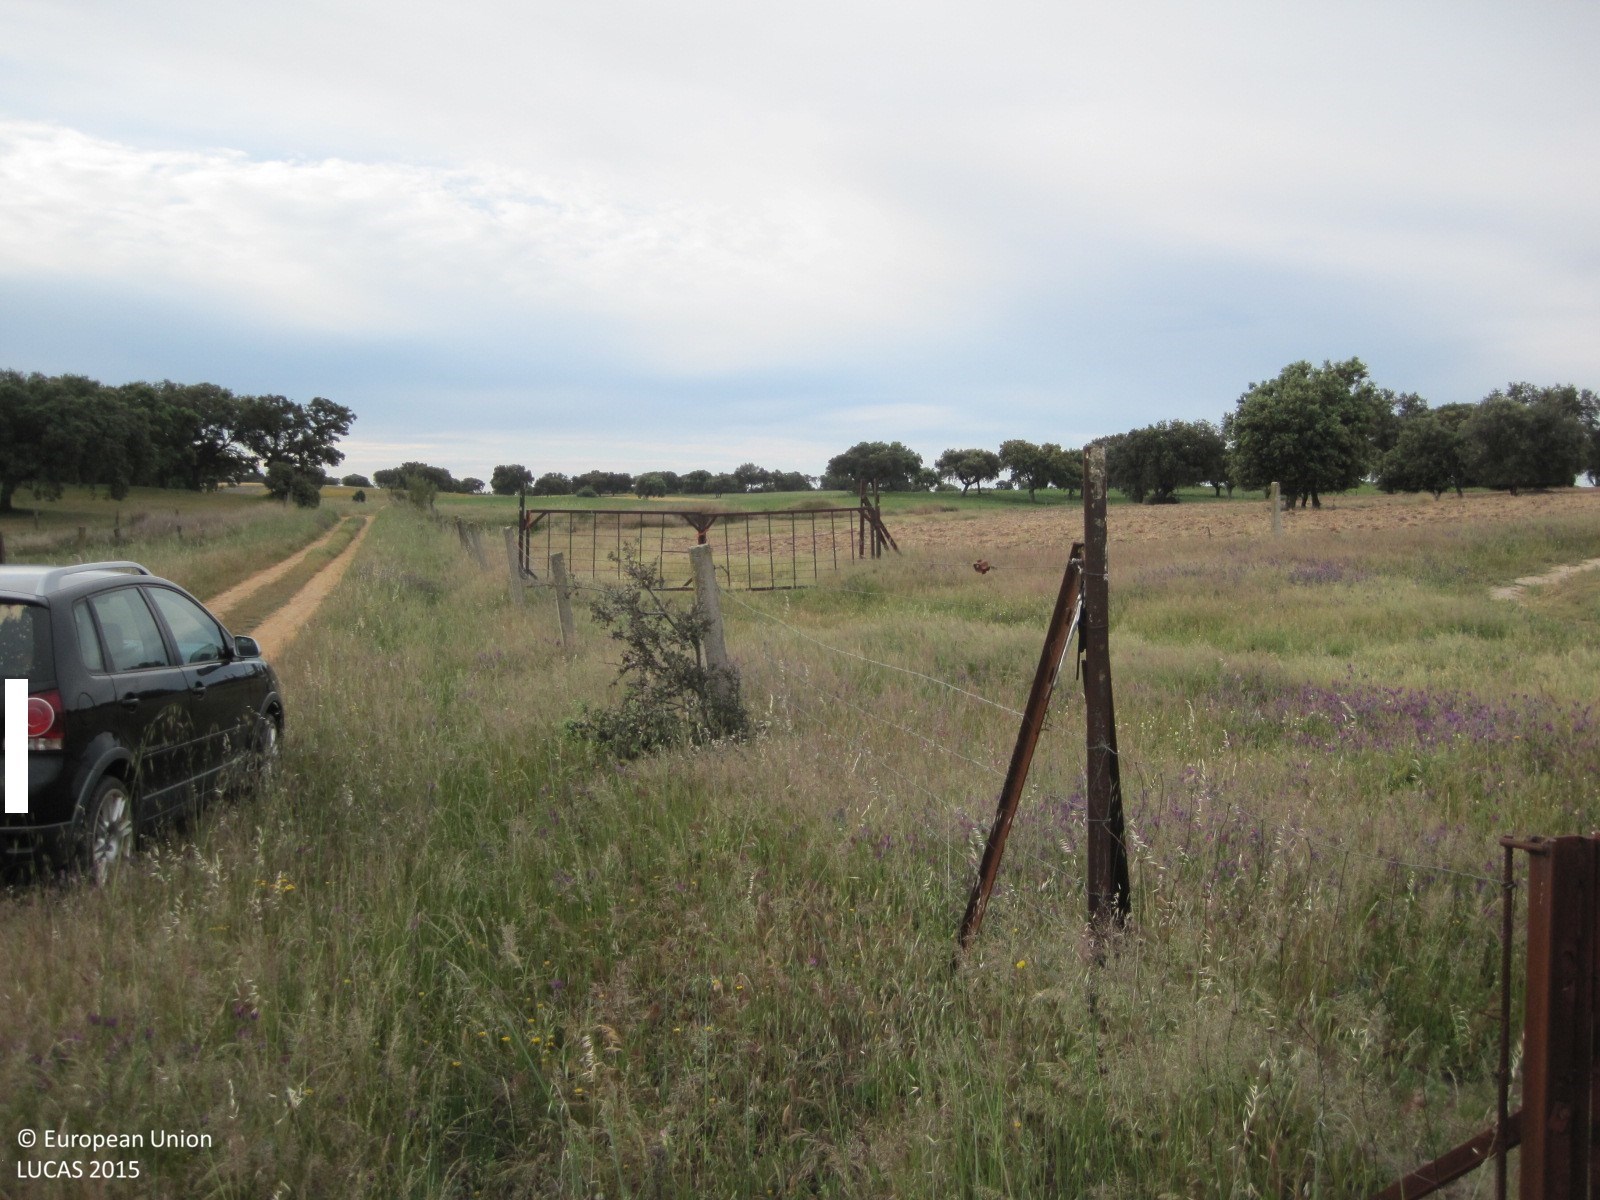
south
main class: Cropland
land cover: Arable land (only in case pi)
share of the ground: > 75 %
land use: Agriculture (excluding fallow land and kitchen gardens)
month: May
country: ES
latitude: 39.8951
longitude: -5.1270
